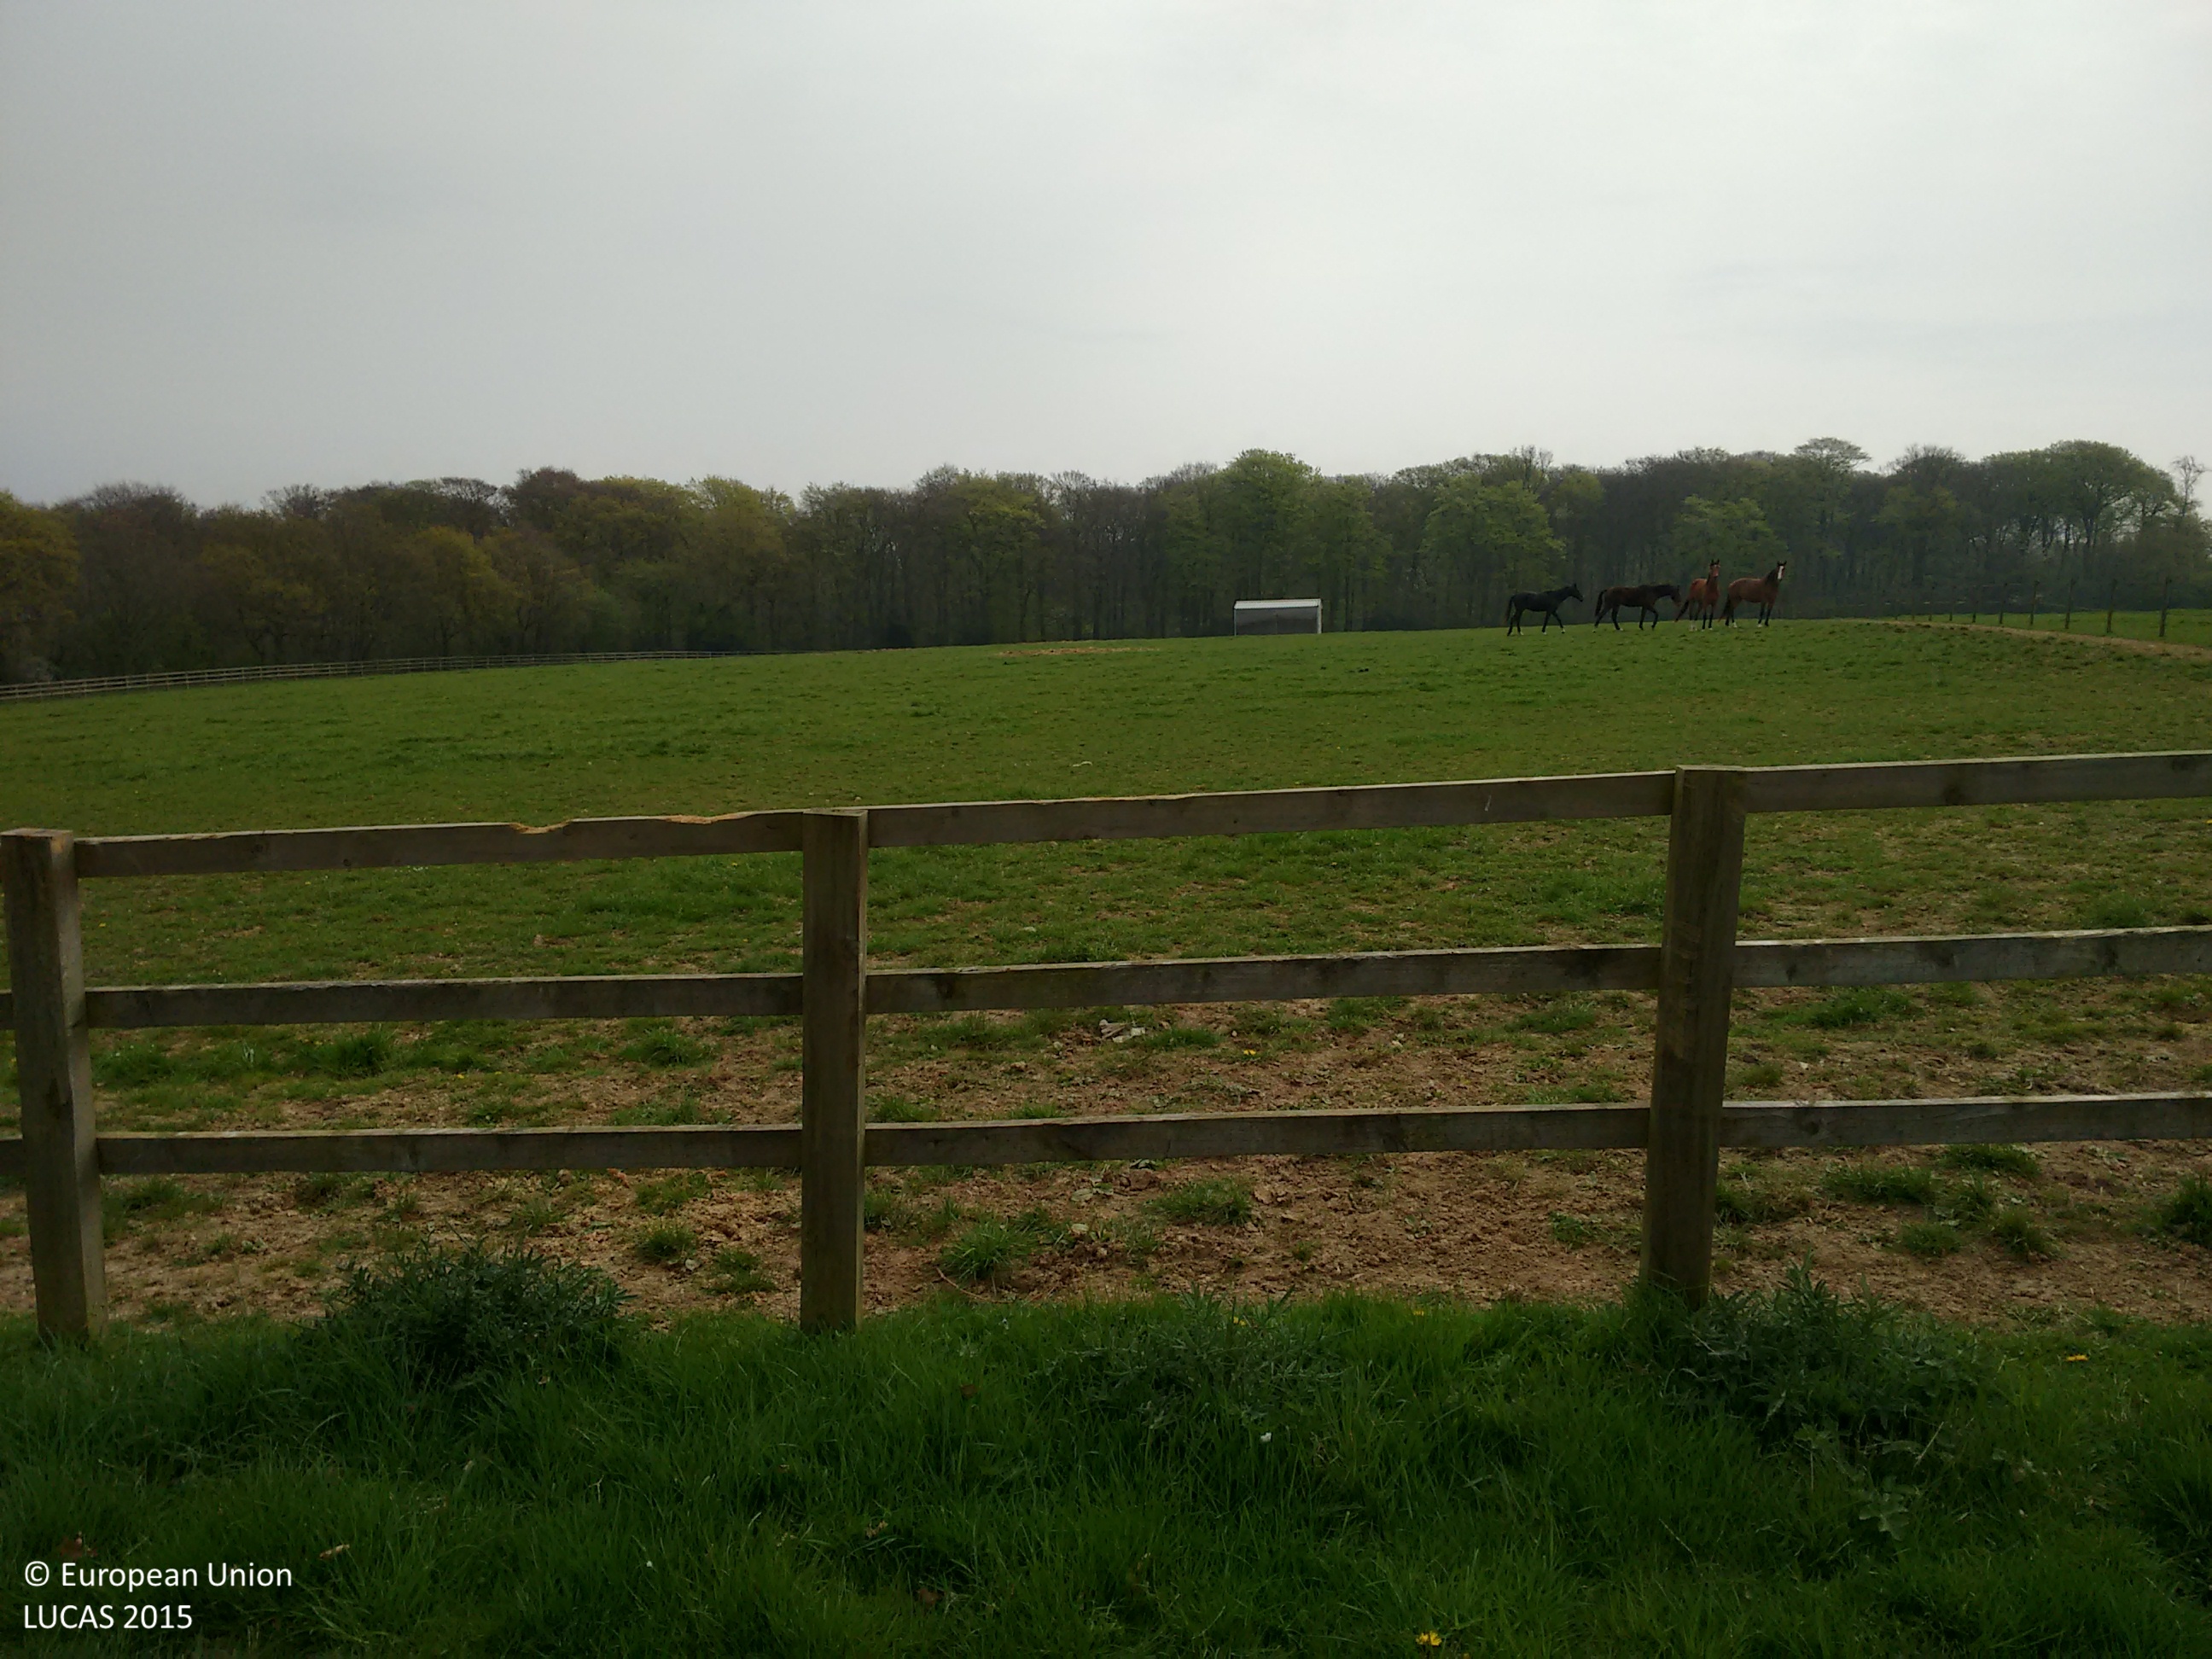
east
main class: Grassland
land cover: Grassland without tree/shrub cover
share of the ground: > 75 %
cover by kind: herbaceous plants 100 %
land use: Agriculture (excluding fallow land and kitchen gardens)
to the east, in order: Grassland without tree/shrub cover; Fences; Grass margins; Fences; Grassland without tree/shrub cover
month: April
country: GB
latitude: 51.7077
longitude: -0.7356
